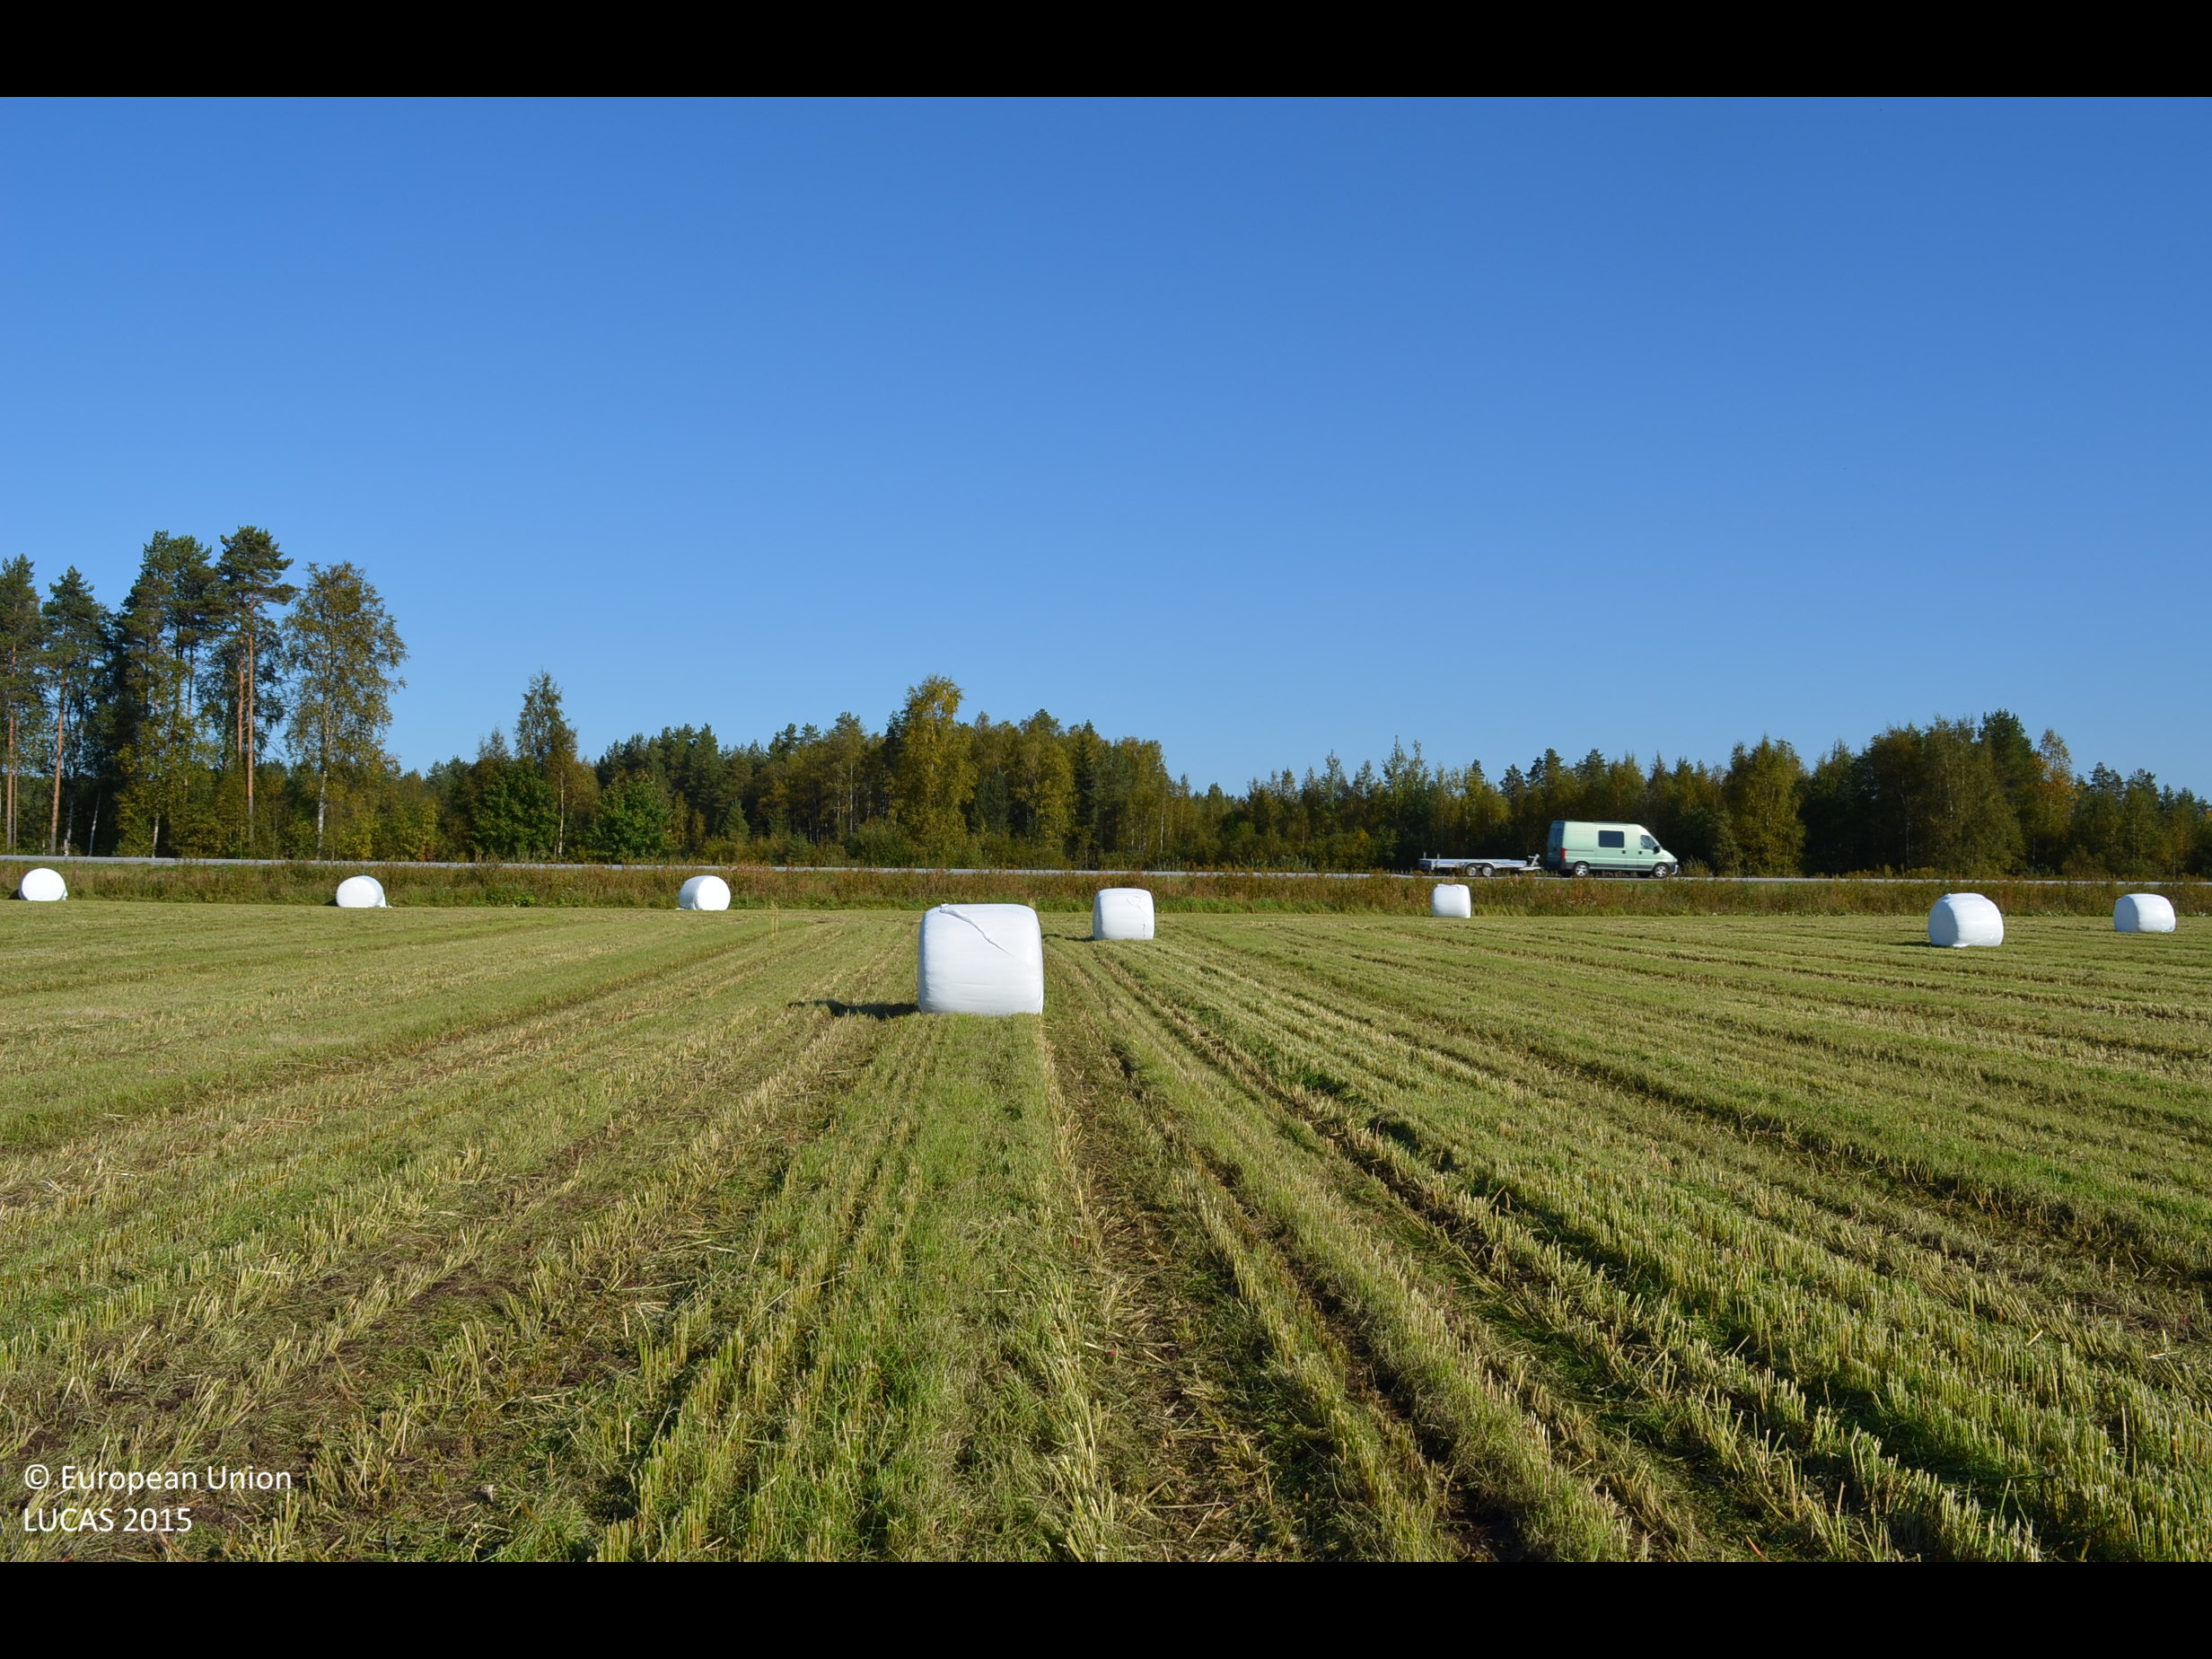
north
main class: Cropland
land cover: Temporary grasslands
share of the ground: > 75 %
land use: Agriculture (excluding fallow land and kitchen gardens)
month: September
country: FI
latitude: 62.7903
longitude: 23.8957
